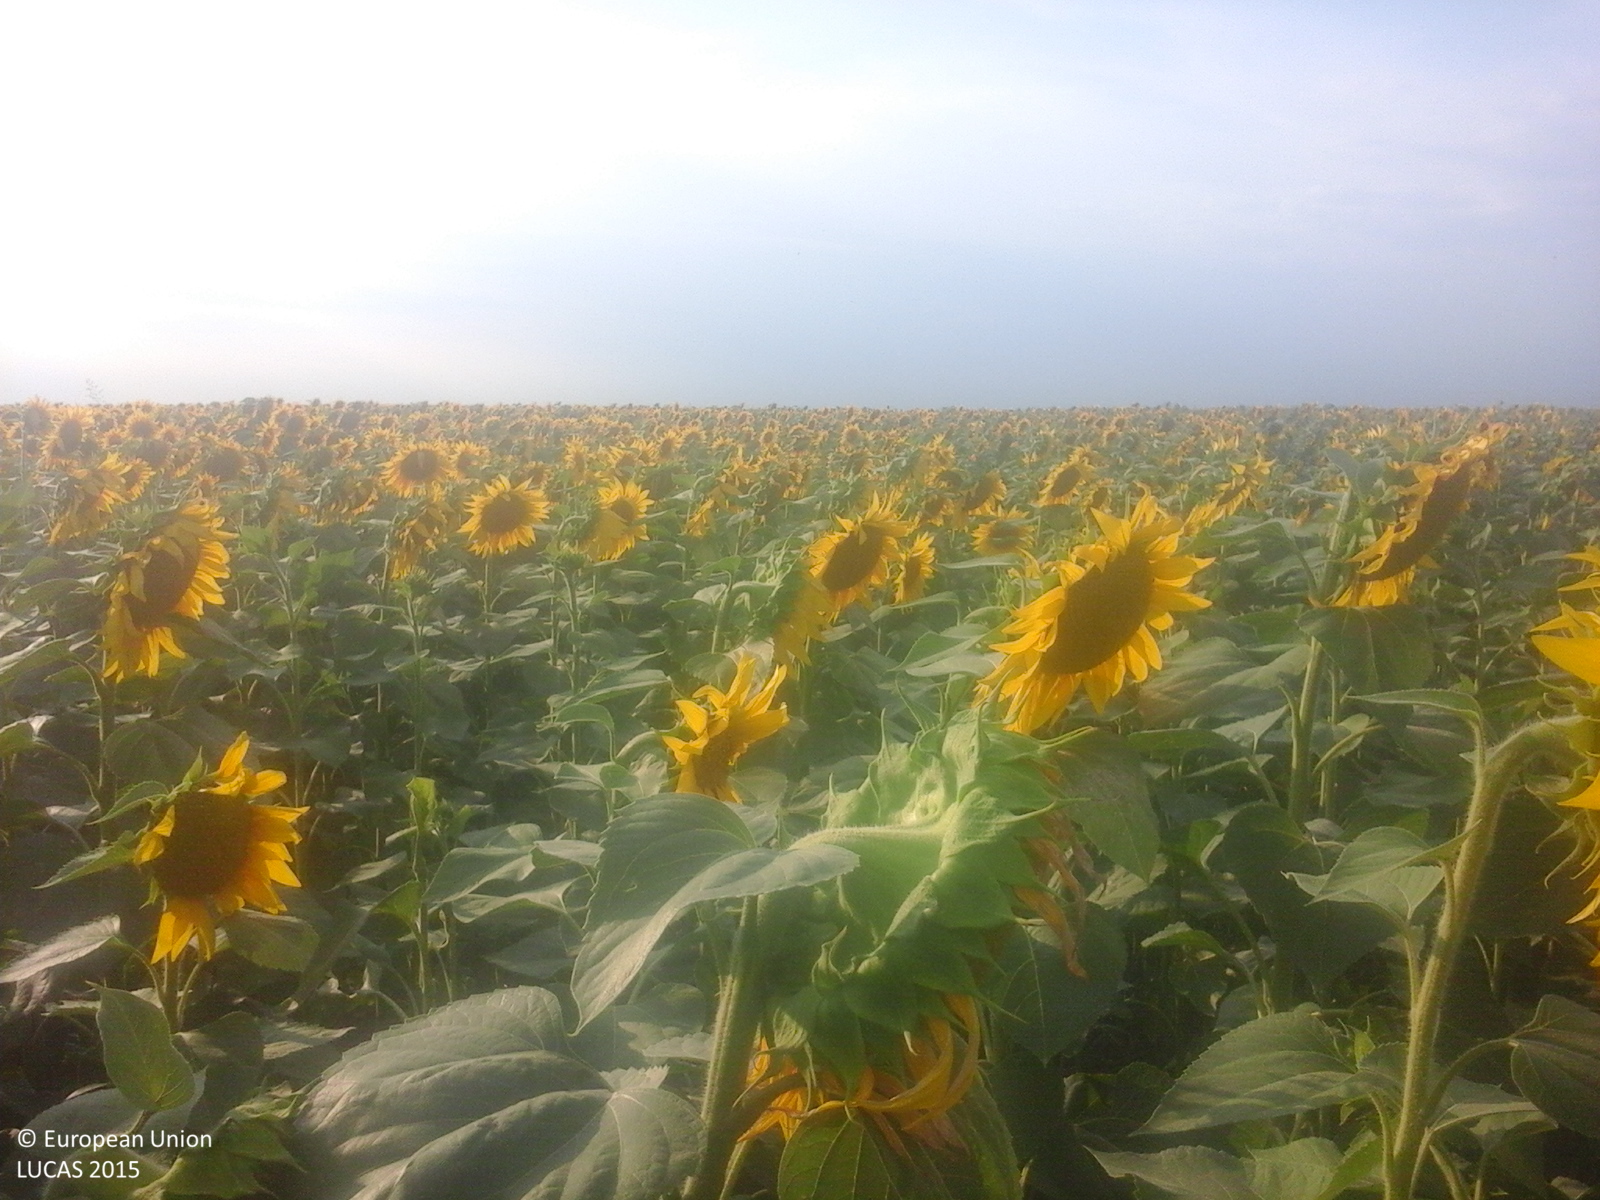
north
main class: Cropland
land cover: Sunflower
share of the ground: > 75 %
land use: Agriculture (excluding fallow land and kitchen gardens)
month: July
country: RO
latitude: 43.8625
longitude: 24.5868
